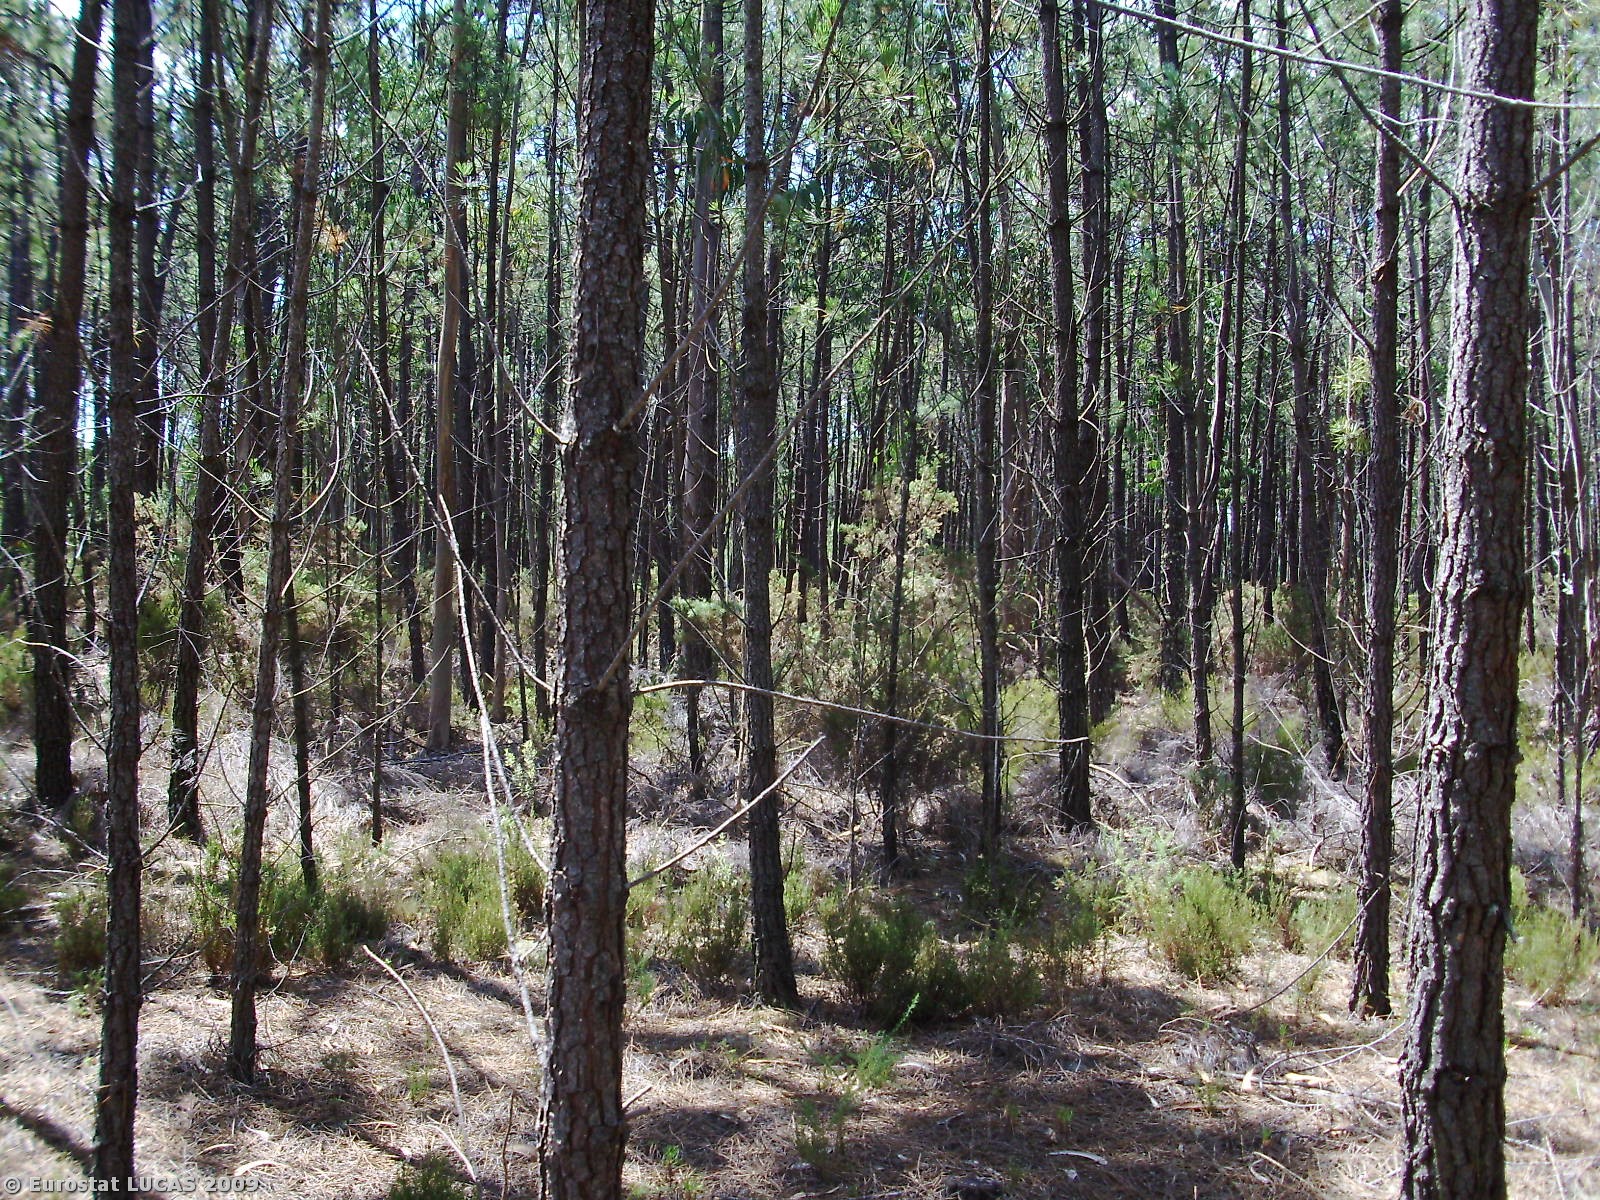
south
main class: Woodland
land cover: Coniferous woodland
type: coniferous forest of the mediterranean region
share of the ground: > 75 %
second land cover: Shrubland with sparse tree cover
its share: 10 - 25 %
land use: Forestry
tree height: > 5 m
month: July
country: PT
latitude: 39.7818
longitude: -8.8996
